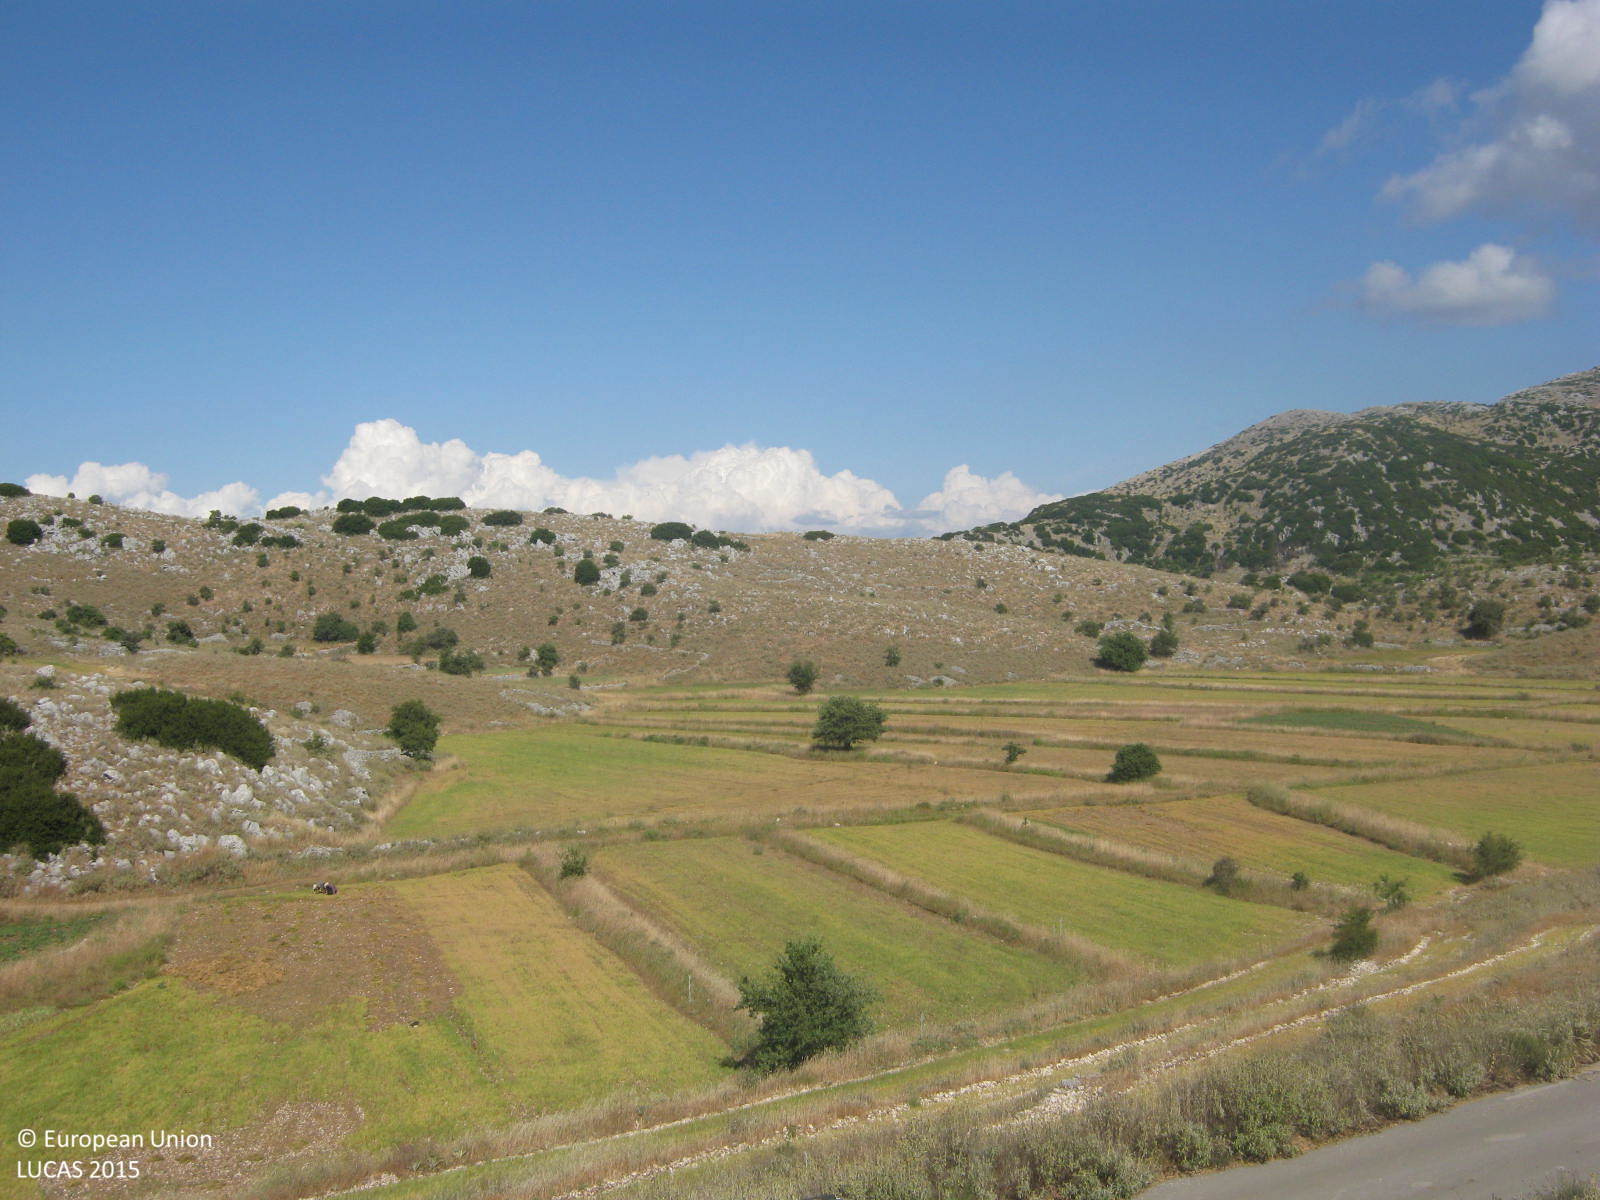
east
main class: Shrubland
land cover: Shrubland without tree cover
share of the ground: 25 - 50 %
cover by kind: shrubs 50 %, herbaceous plants 25 %, consolidated bare surface 25 %
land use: Semi-natural and natural areas not in use
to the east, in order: Shrubland without tree cover; Paved roads, cycling and walking lanes; Shrubland without tree cover; Fences; Dry pulses; Fences; Grass margins; Tracks; Shruby margins; Spontaneously vegetated surfaces; Other leguminous and mixtures for fodder; Single bushes/trees; Dry stone walls; Single bushes/trees; Spontaneously vegetated surfaces; Dry stone walls; Shrubland without tree cover
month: June
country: GR
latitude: 38.7212
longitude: 20.6293
